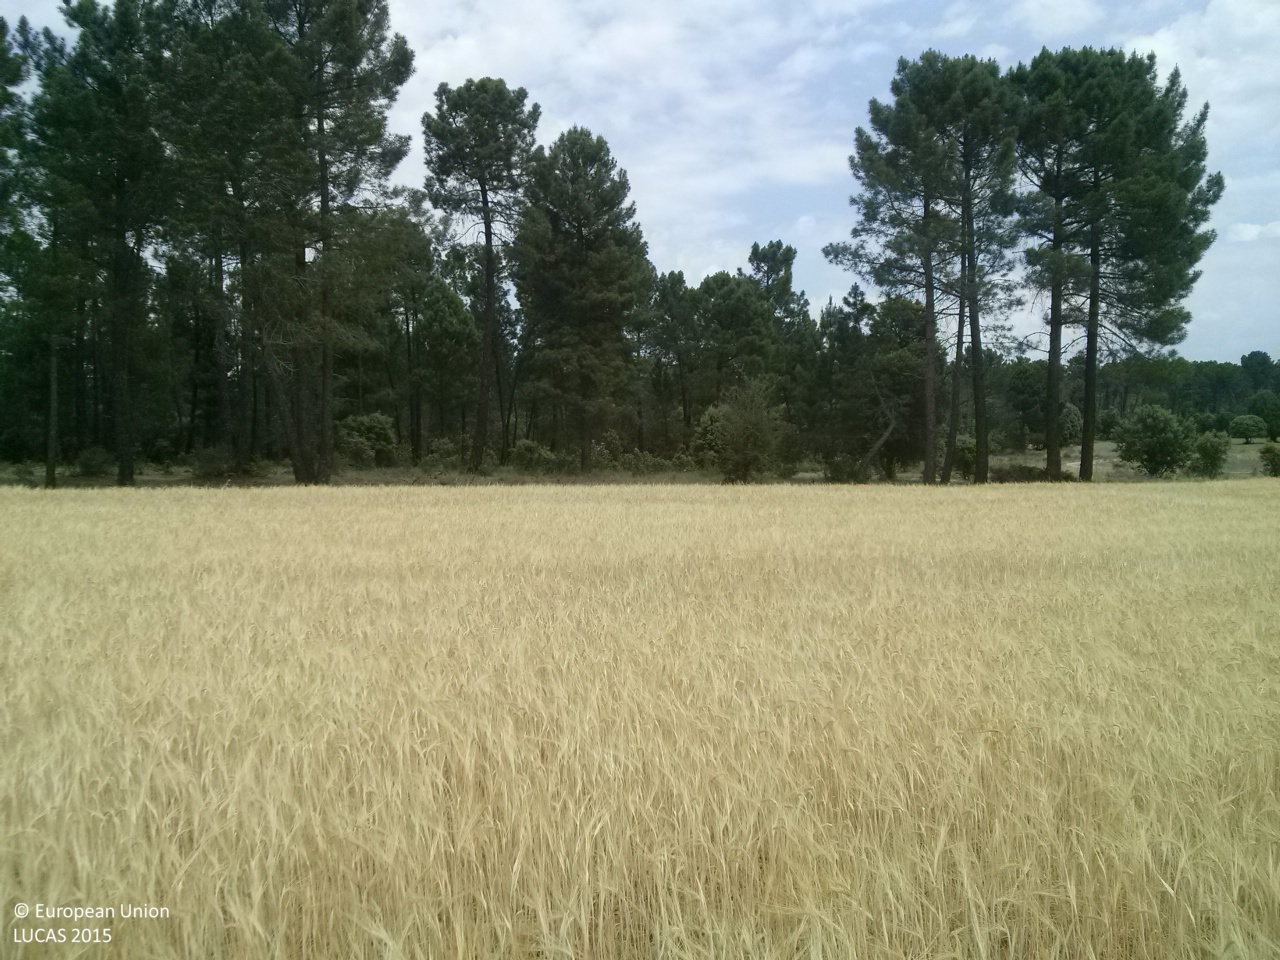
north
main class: Cropland
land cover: Barley
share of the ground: > 75 %
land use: Agriculture (excluding fallow land and kitchen gardens)
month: June
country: ES
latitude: 39.9724
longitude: -1.8023
